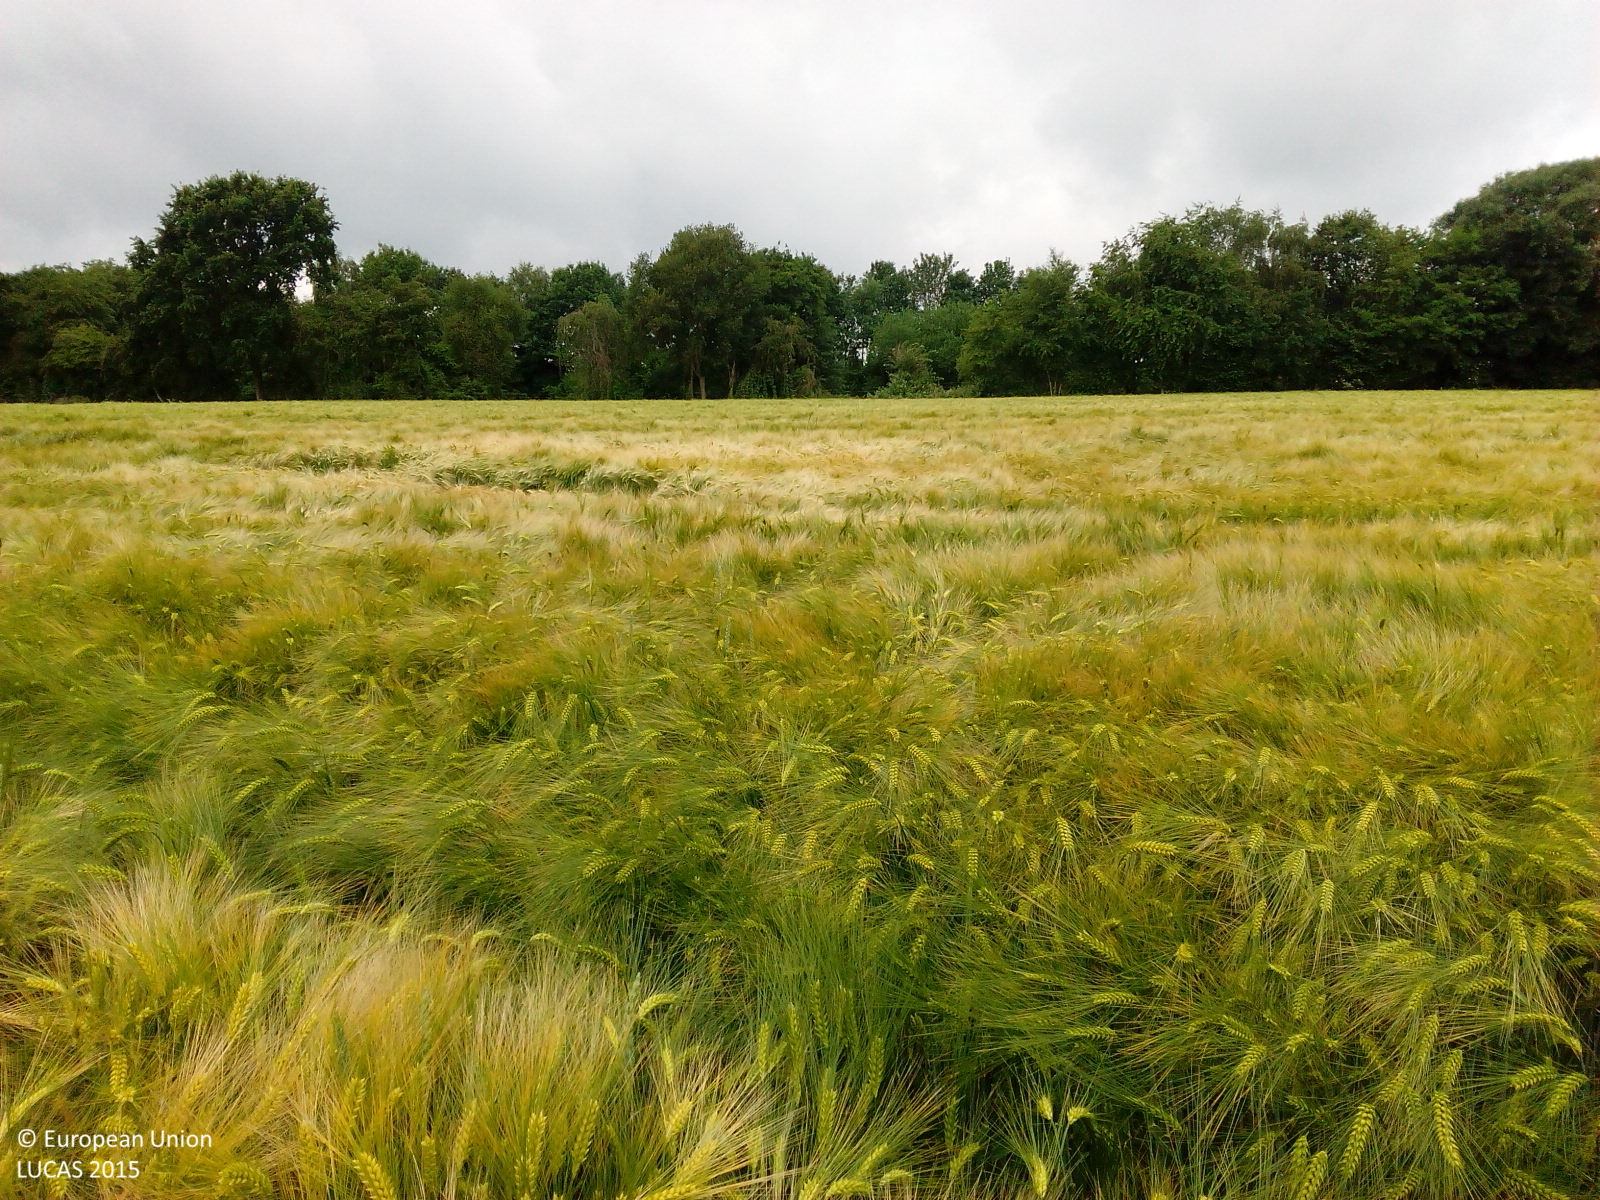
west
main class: Cropland
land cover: Barley
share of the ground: > 75 %
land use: Agriculture (excluding fallow land and kitchen gardens)
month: June
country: DE
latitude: 51.6039
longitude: 7.0691
